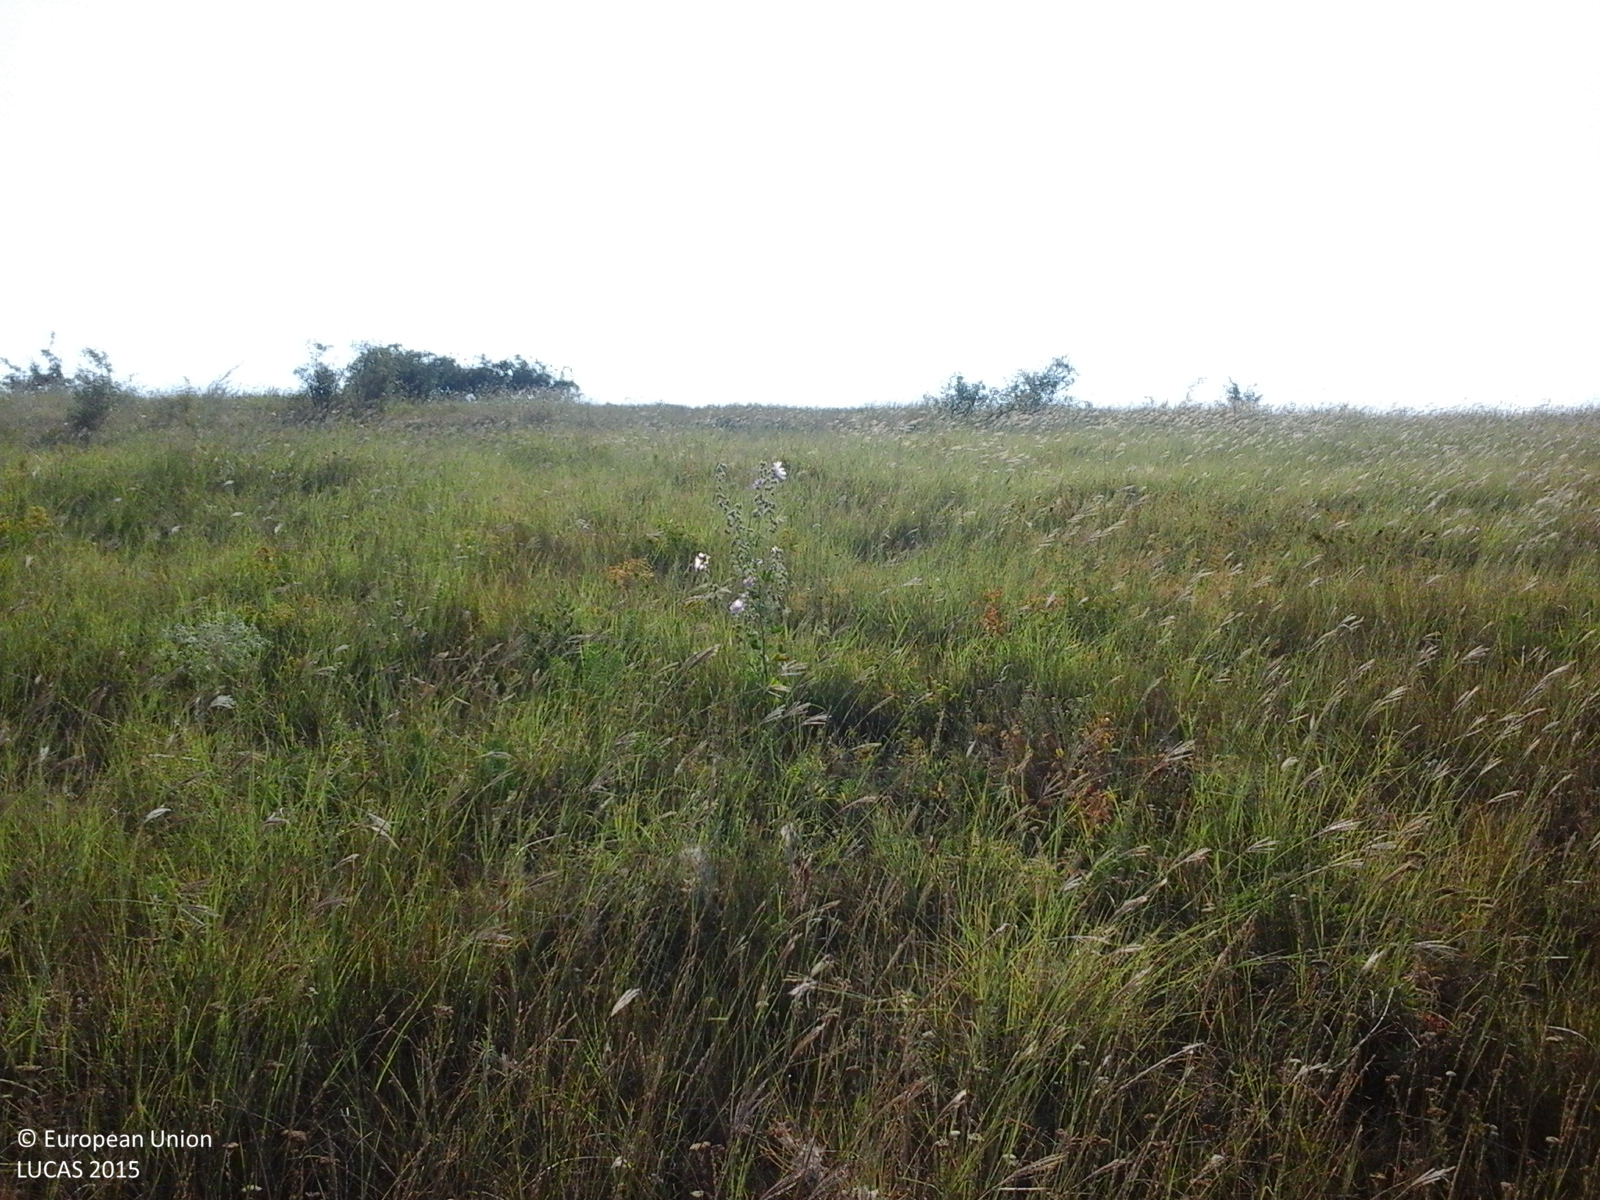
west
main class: Grassland
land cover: Grassland with sparse tree/shrub cover
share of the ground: > 75 %
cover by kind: herbaceous plants 90 %, broadleaved forest trees 5 %, shrubs 5 %
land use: Agriculture (excluding fallow land and kitchen gardens)
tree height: < 5 m
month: July
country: RO
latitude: 45.9386
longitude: 27.6390
